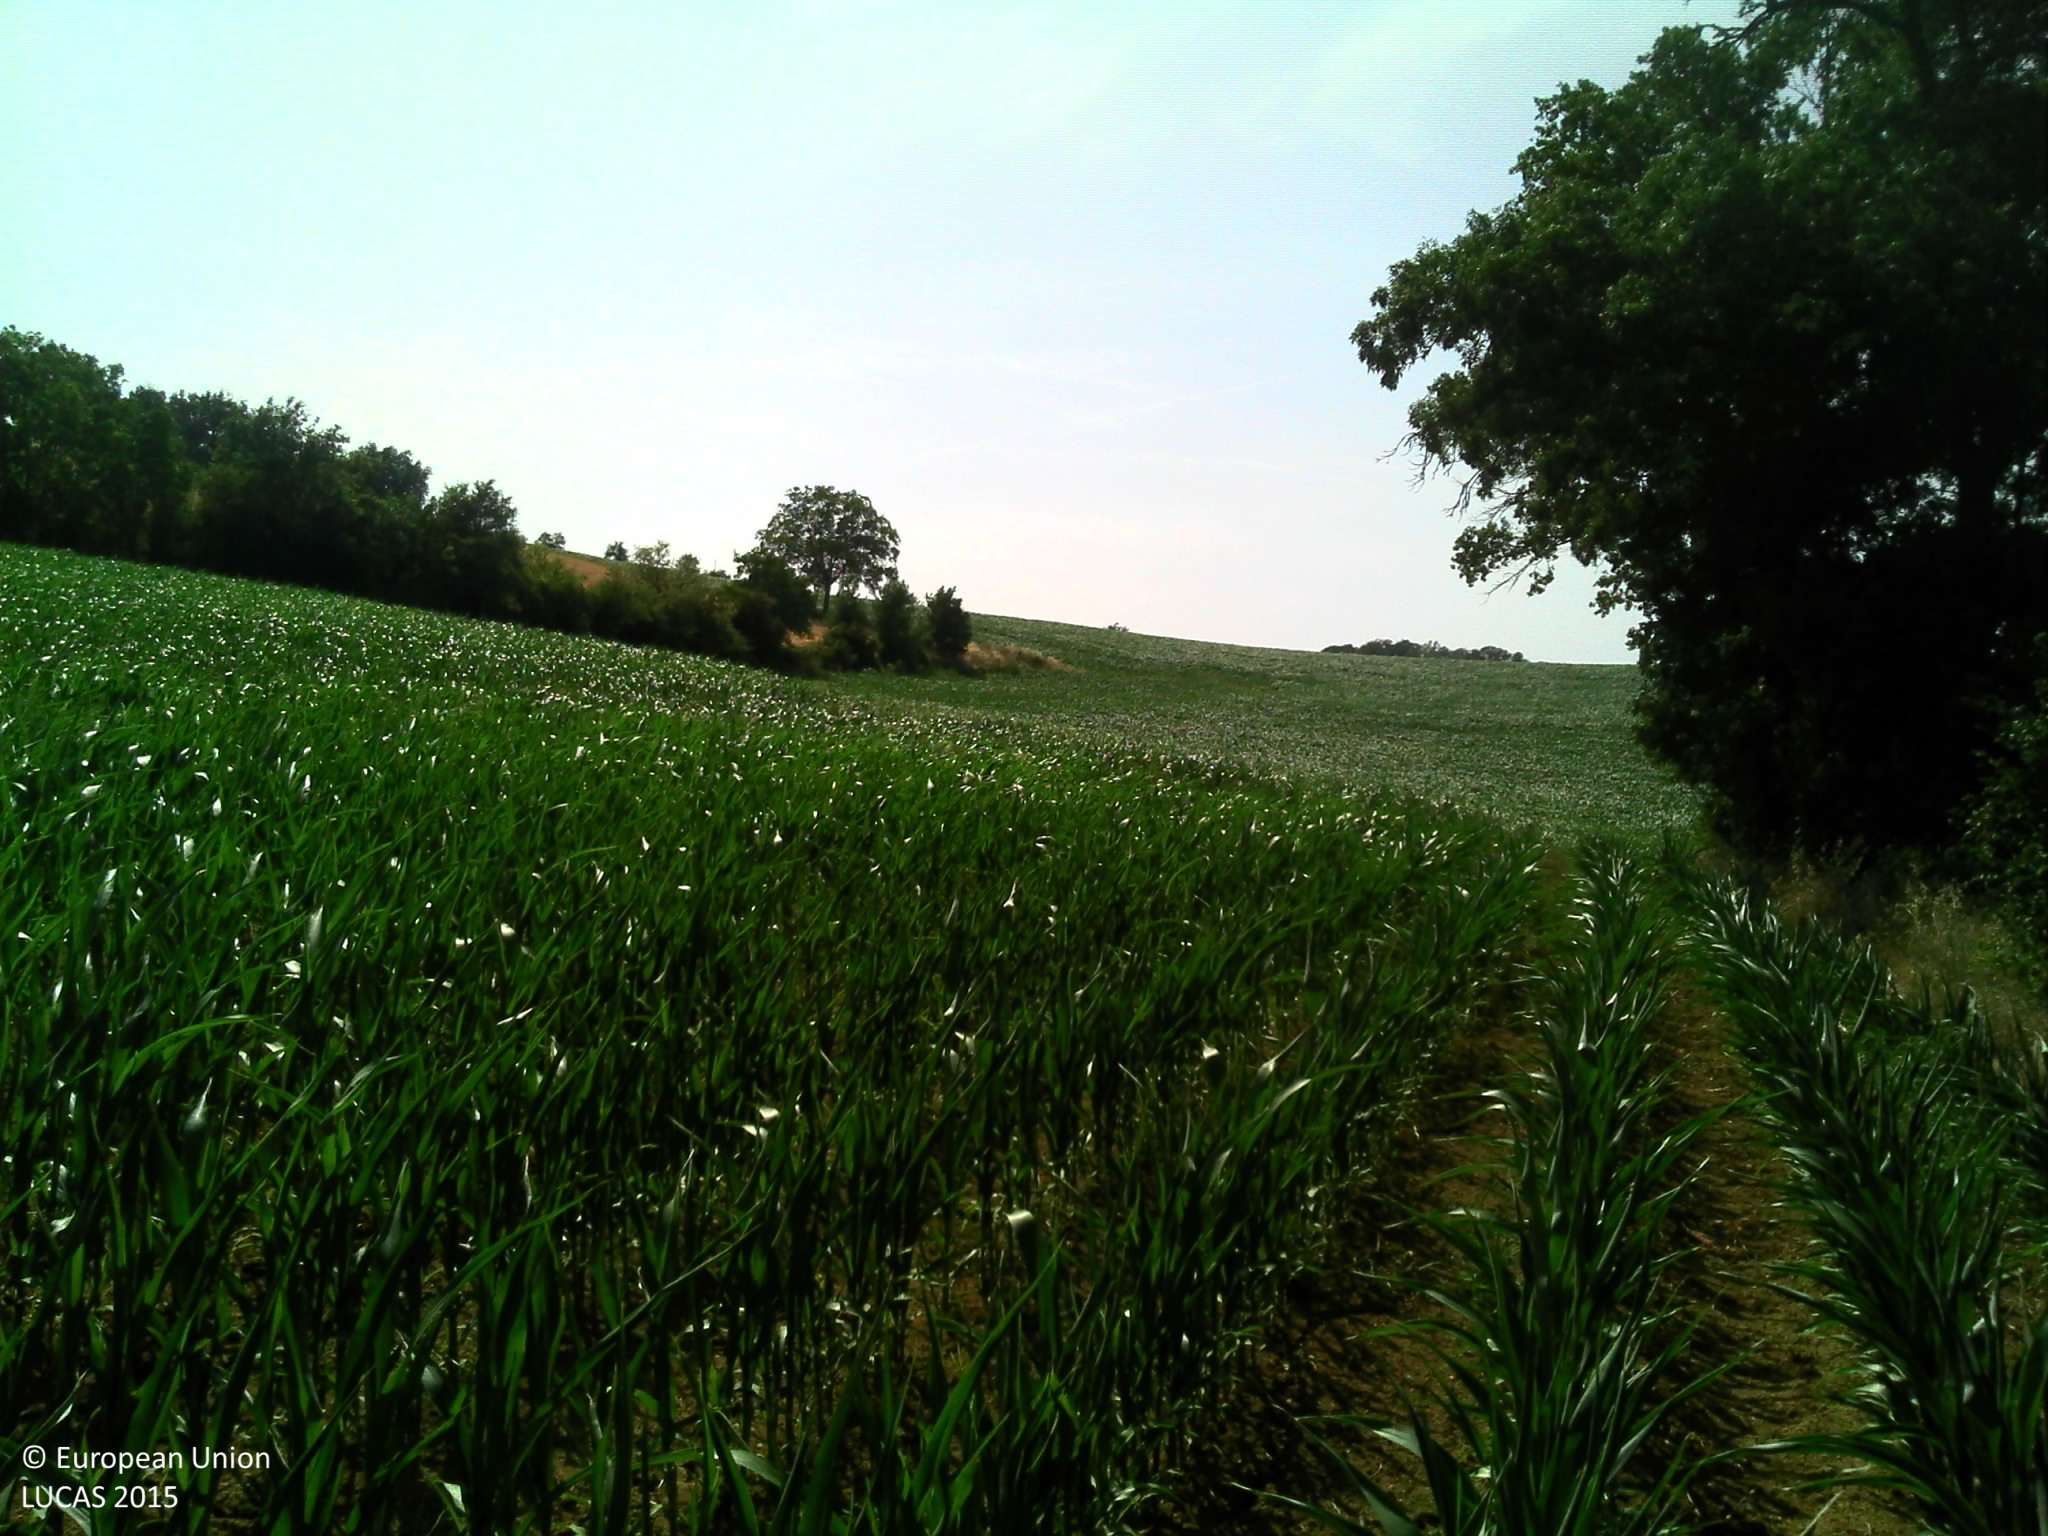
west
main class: Cropland
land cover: Maize
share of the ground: > 75 %
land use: Agriculture (excluding fallow land and kitchen gardens)
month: July
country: FR
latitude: 43.5502
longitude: 1.7483
